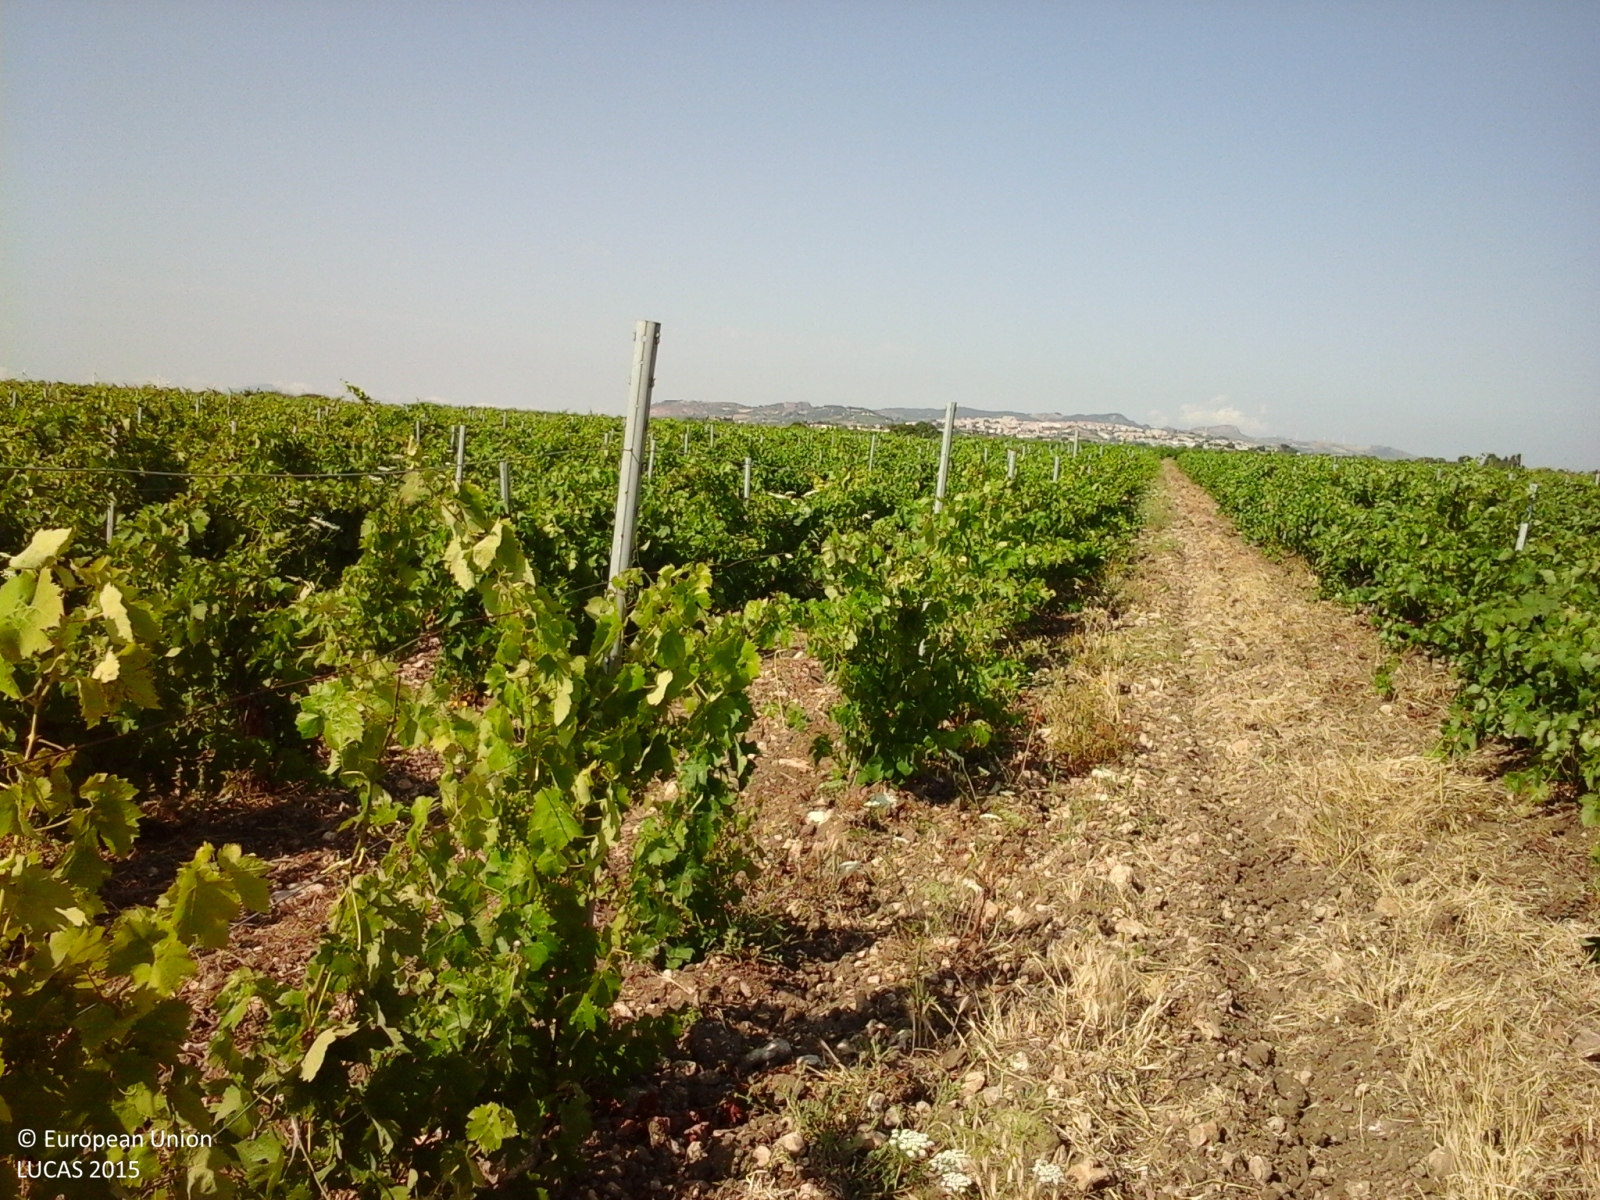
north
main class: Cropland
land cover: Vineyards
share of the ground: 25 - 50 %
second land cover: Other bare soil
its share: > 75 %
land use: Agriculture (excluding fallow land and kitchen gardens)
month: June
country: IT
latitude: 37.7419
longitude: 12.8272
